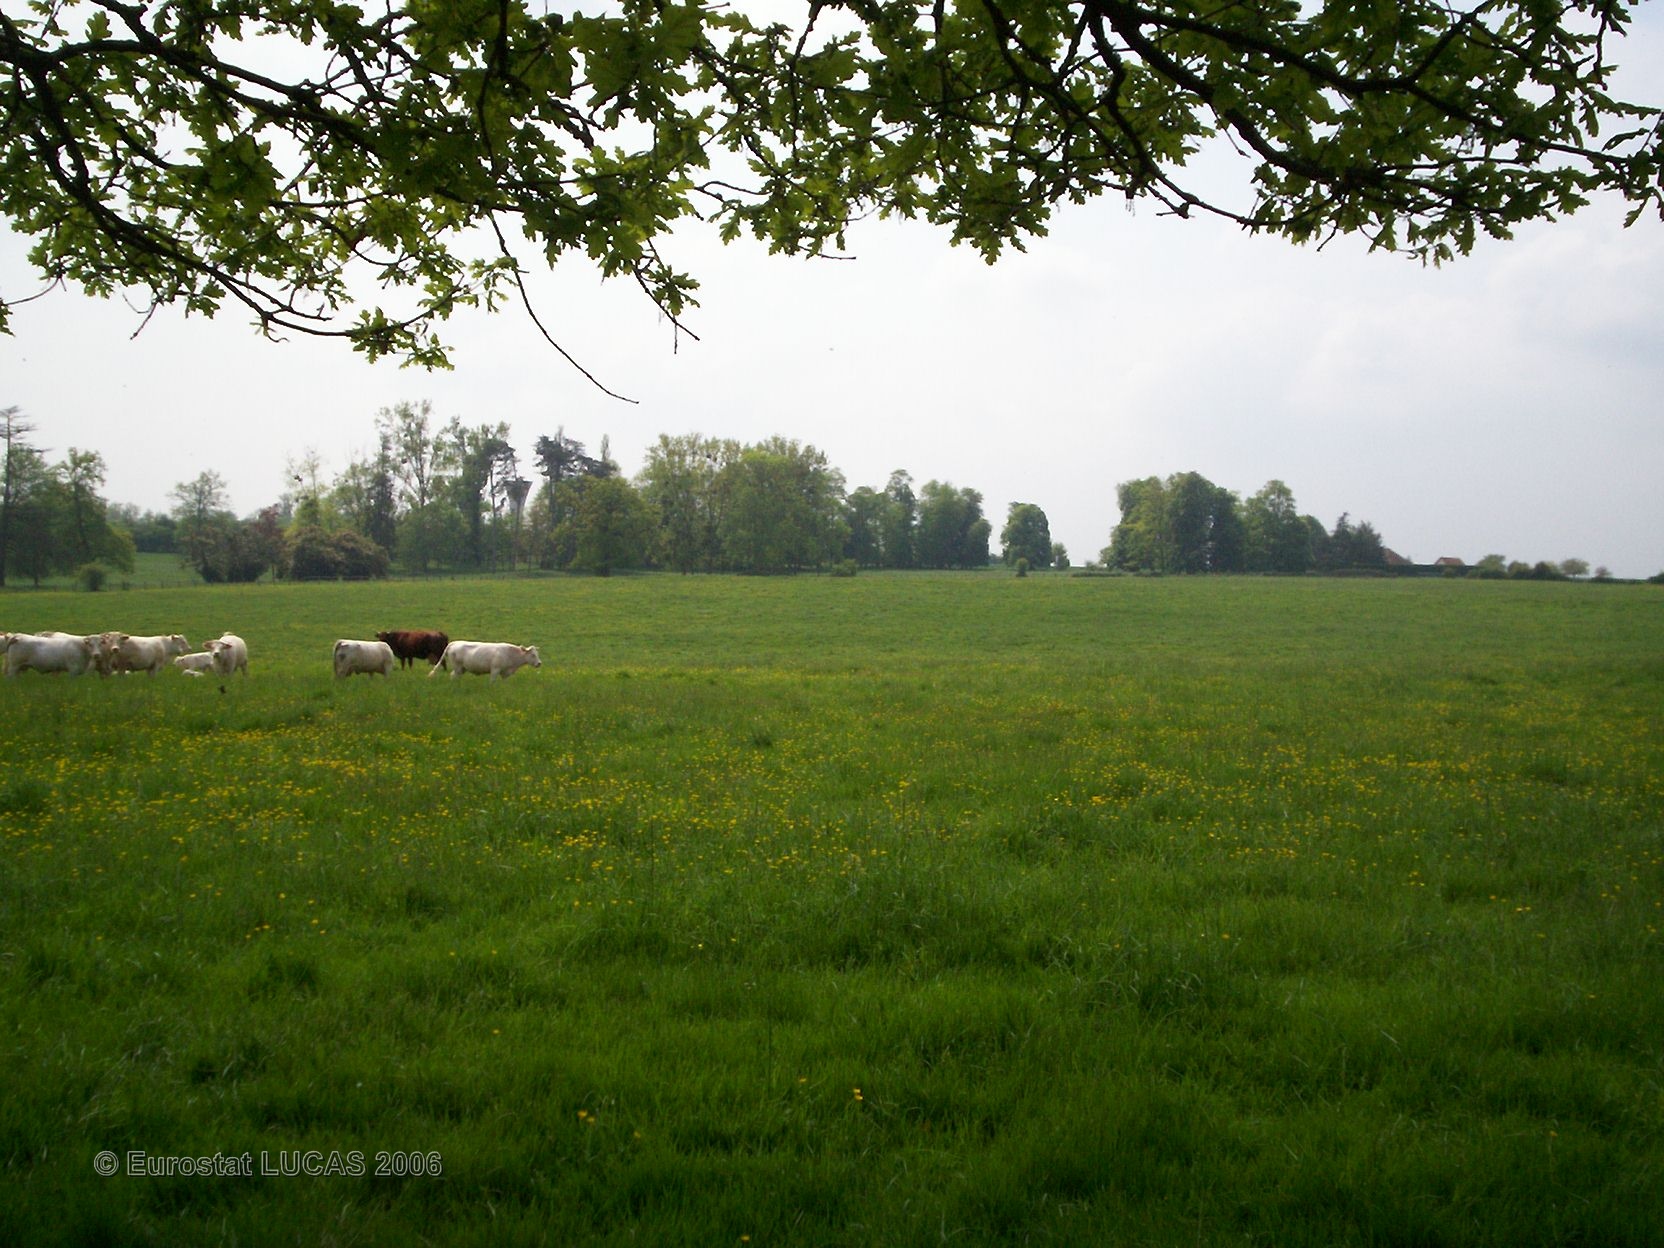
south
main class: Grassland
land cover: Grassland without tree/shrub cover
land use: Agriculture (excluding fallow land and kitchen gardens)
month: May
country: FR
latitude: 48.4644
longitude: 0.0852
